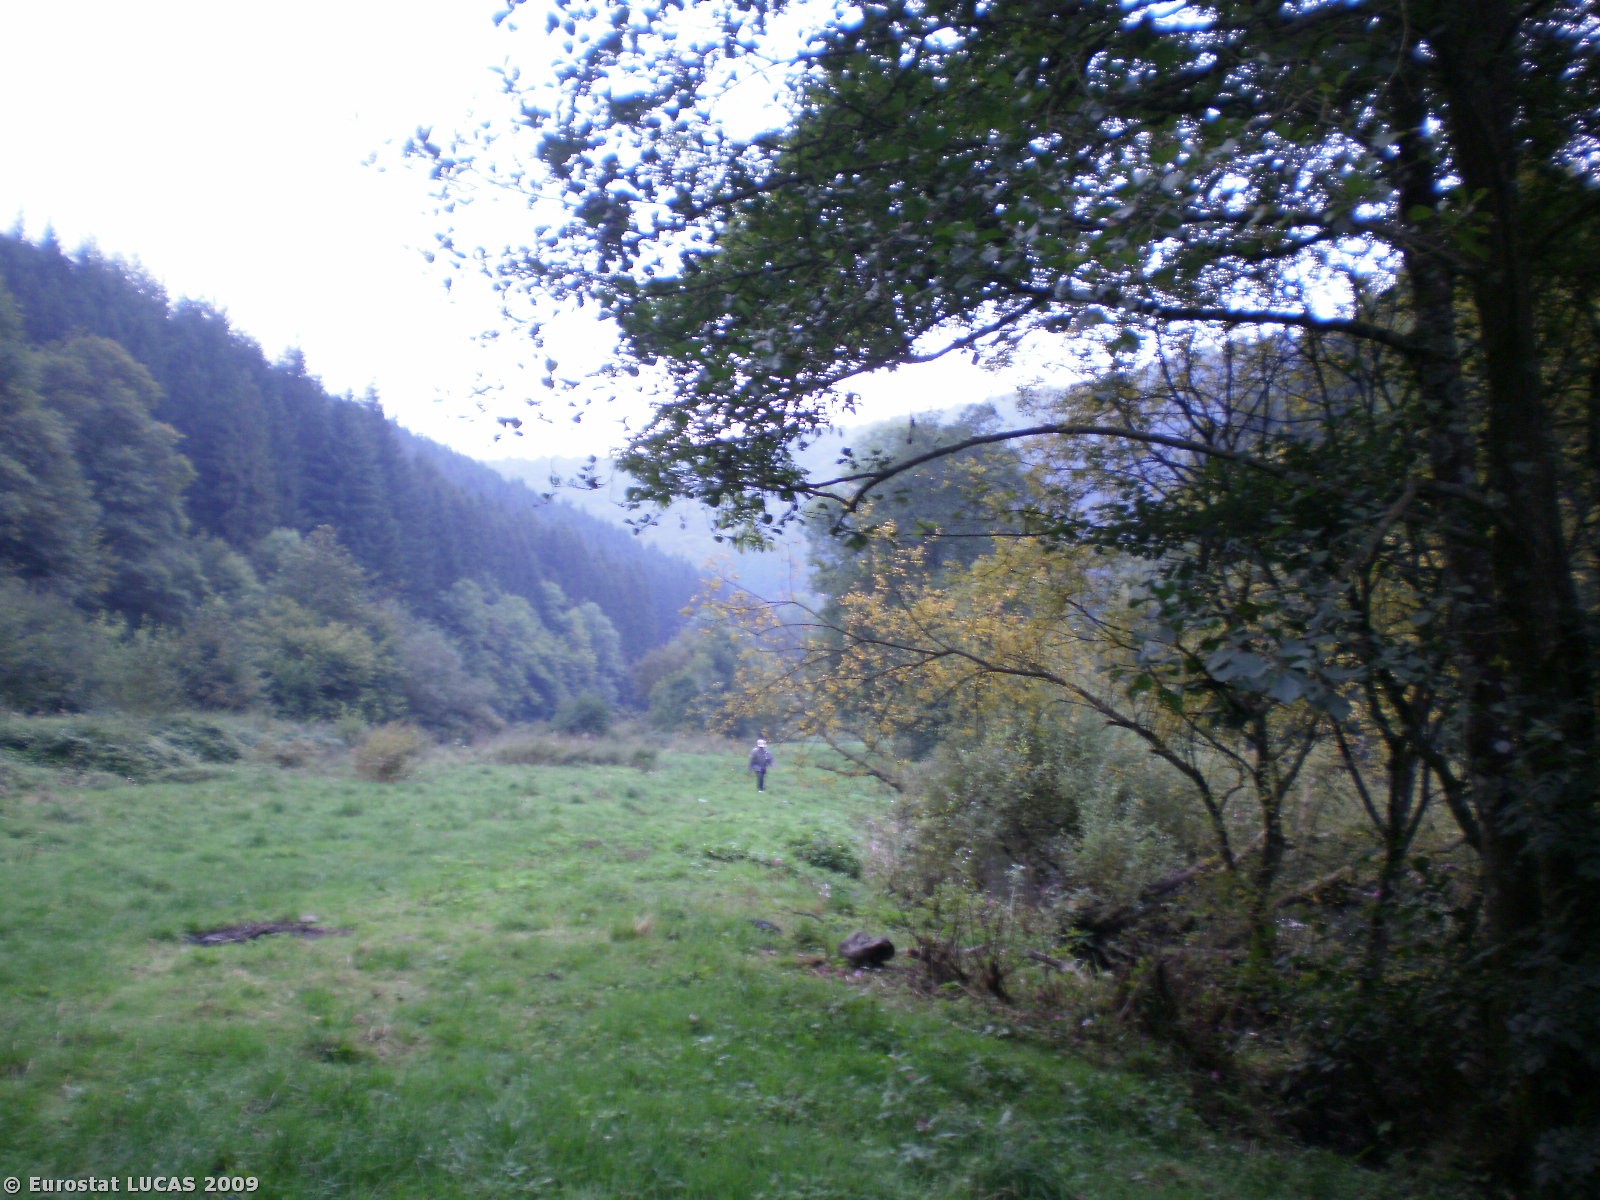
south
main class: Woodland
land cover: Broadleaved woodland
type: mountainous beech forest
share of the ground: > 75 %
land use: Forestry
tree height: > 5 m
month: September
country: BE
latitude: 50.1720
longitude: 5.6161
